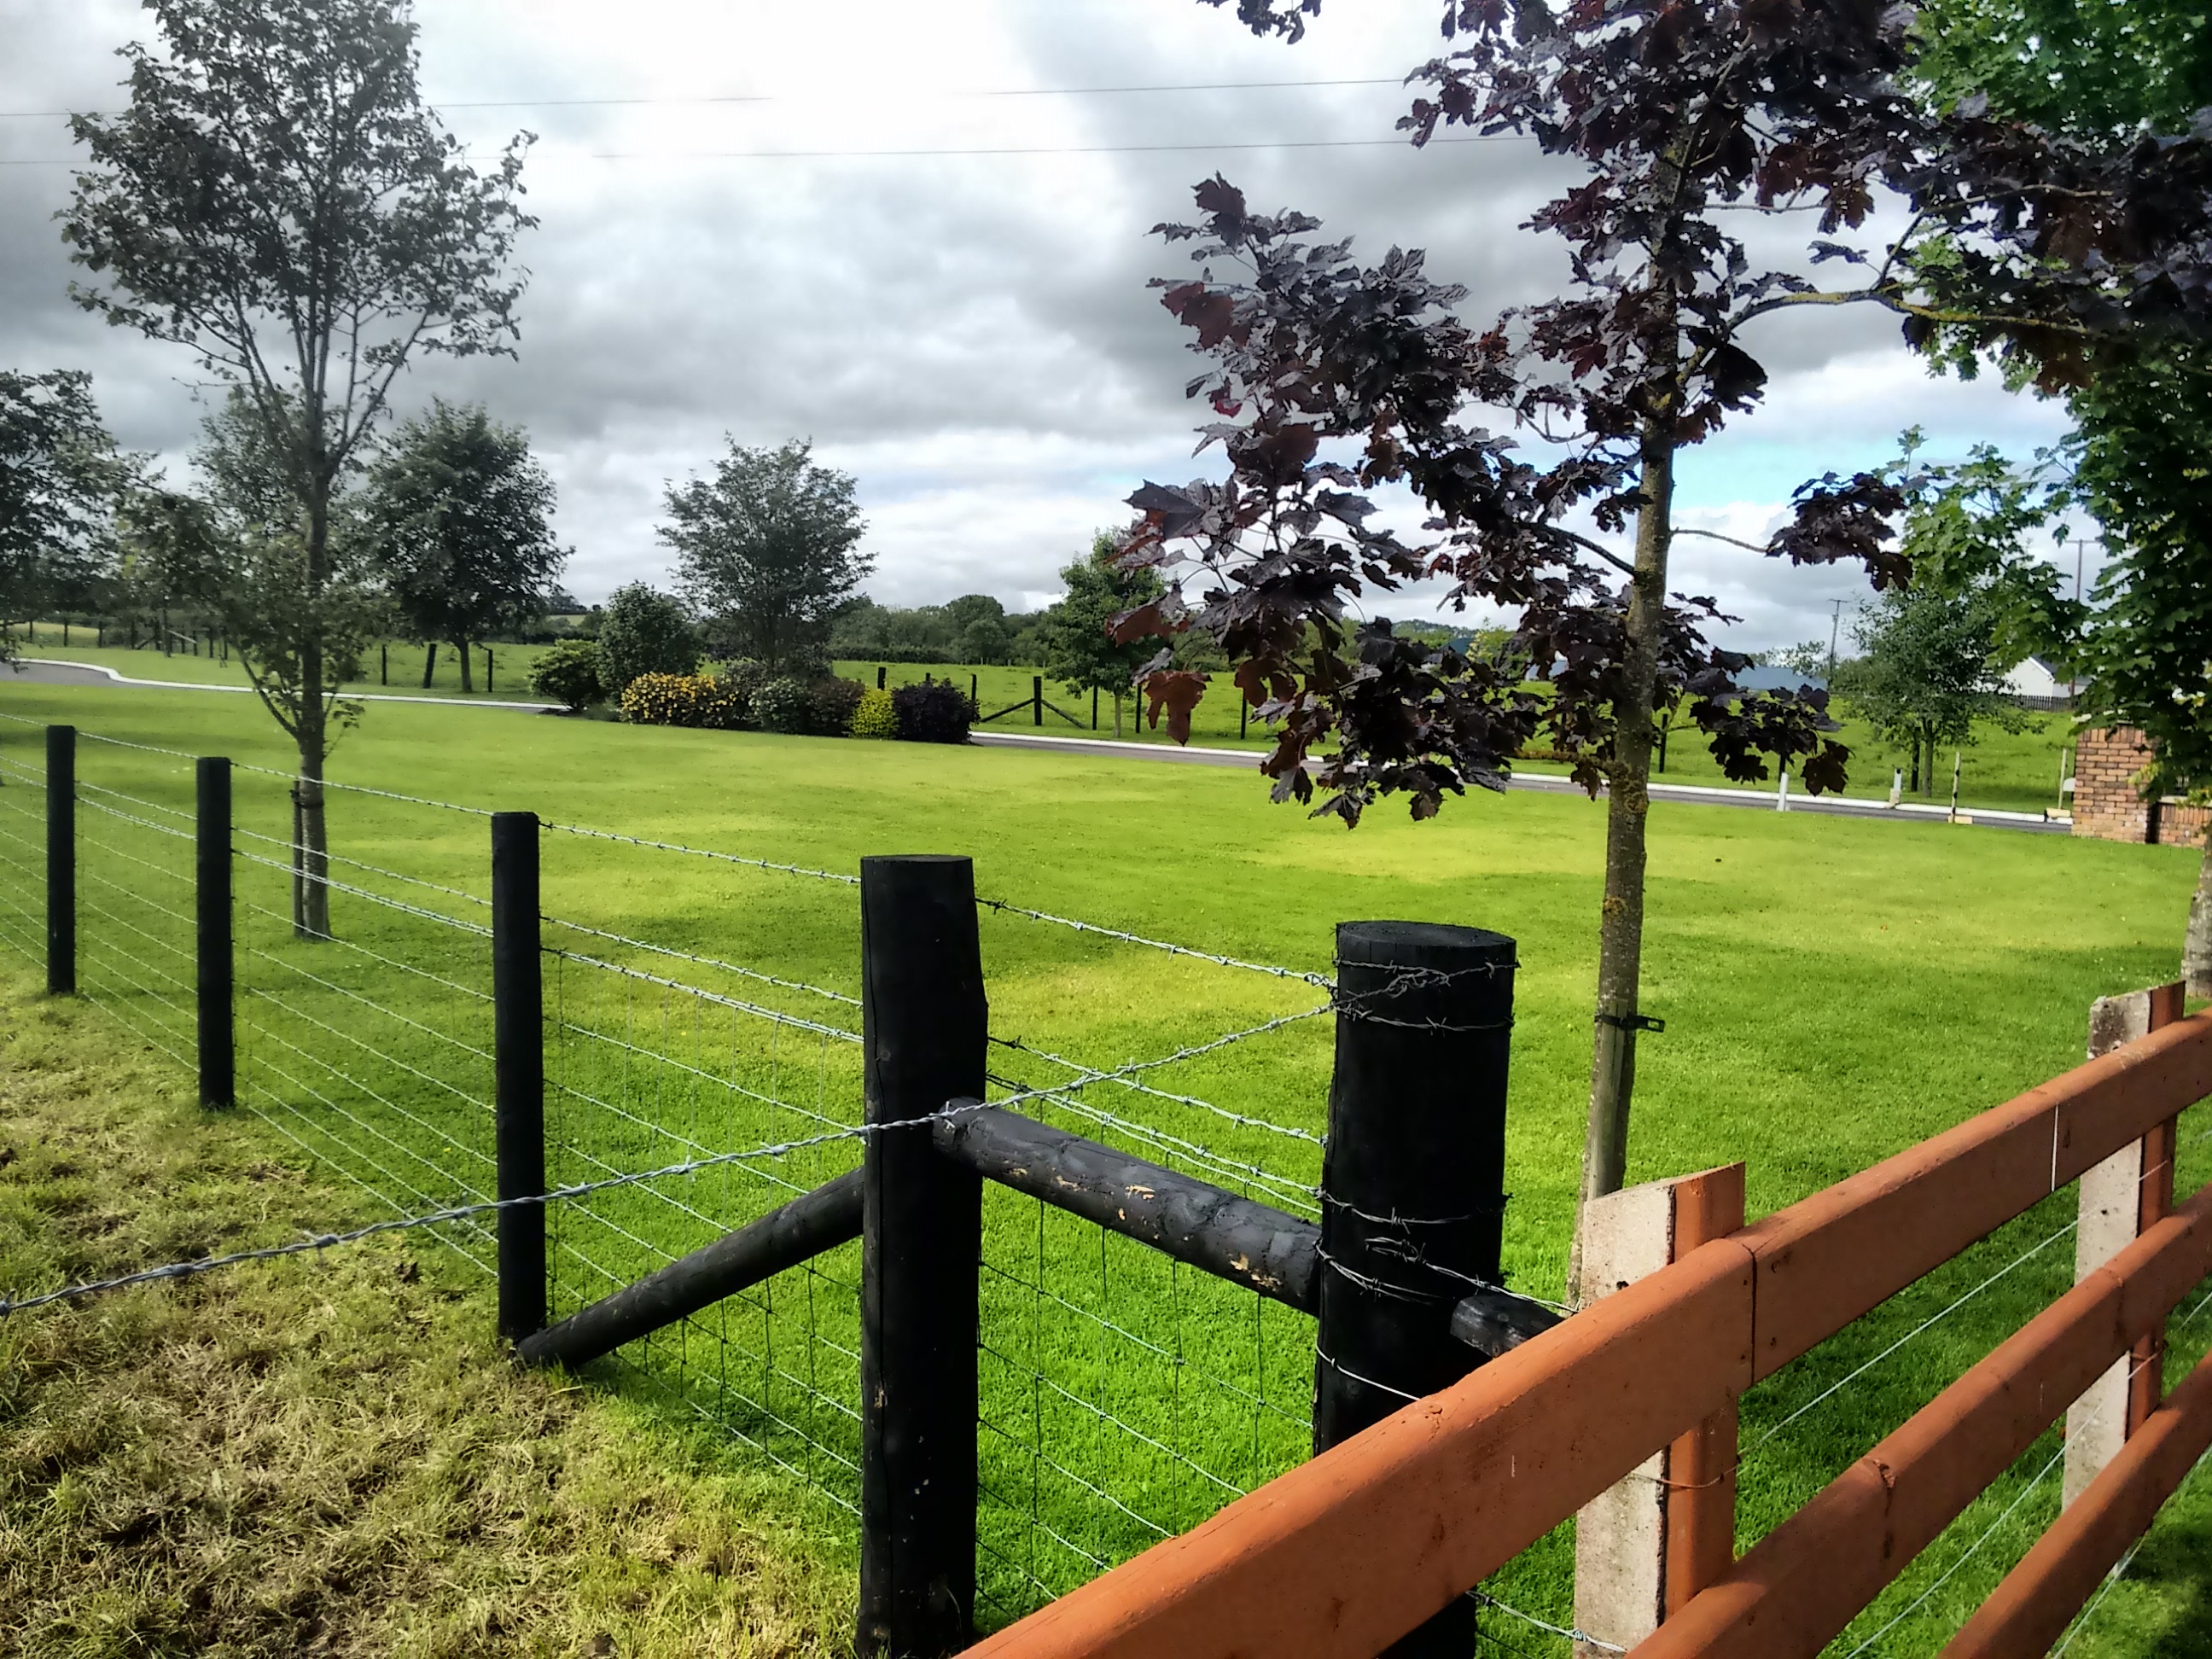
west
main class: Grassland
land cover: Grassland without tree/shrub cover
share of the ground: > 75 %
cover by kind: herbaceous plants 100 %
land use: Agriculture (excluding fallow land and kitchen gardens)
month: August
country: GB
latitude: 54.4499
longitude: -6.7418
